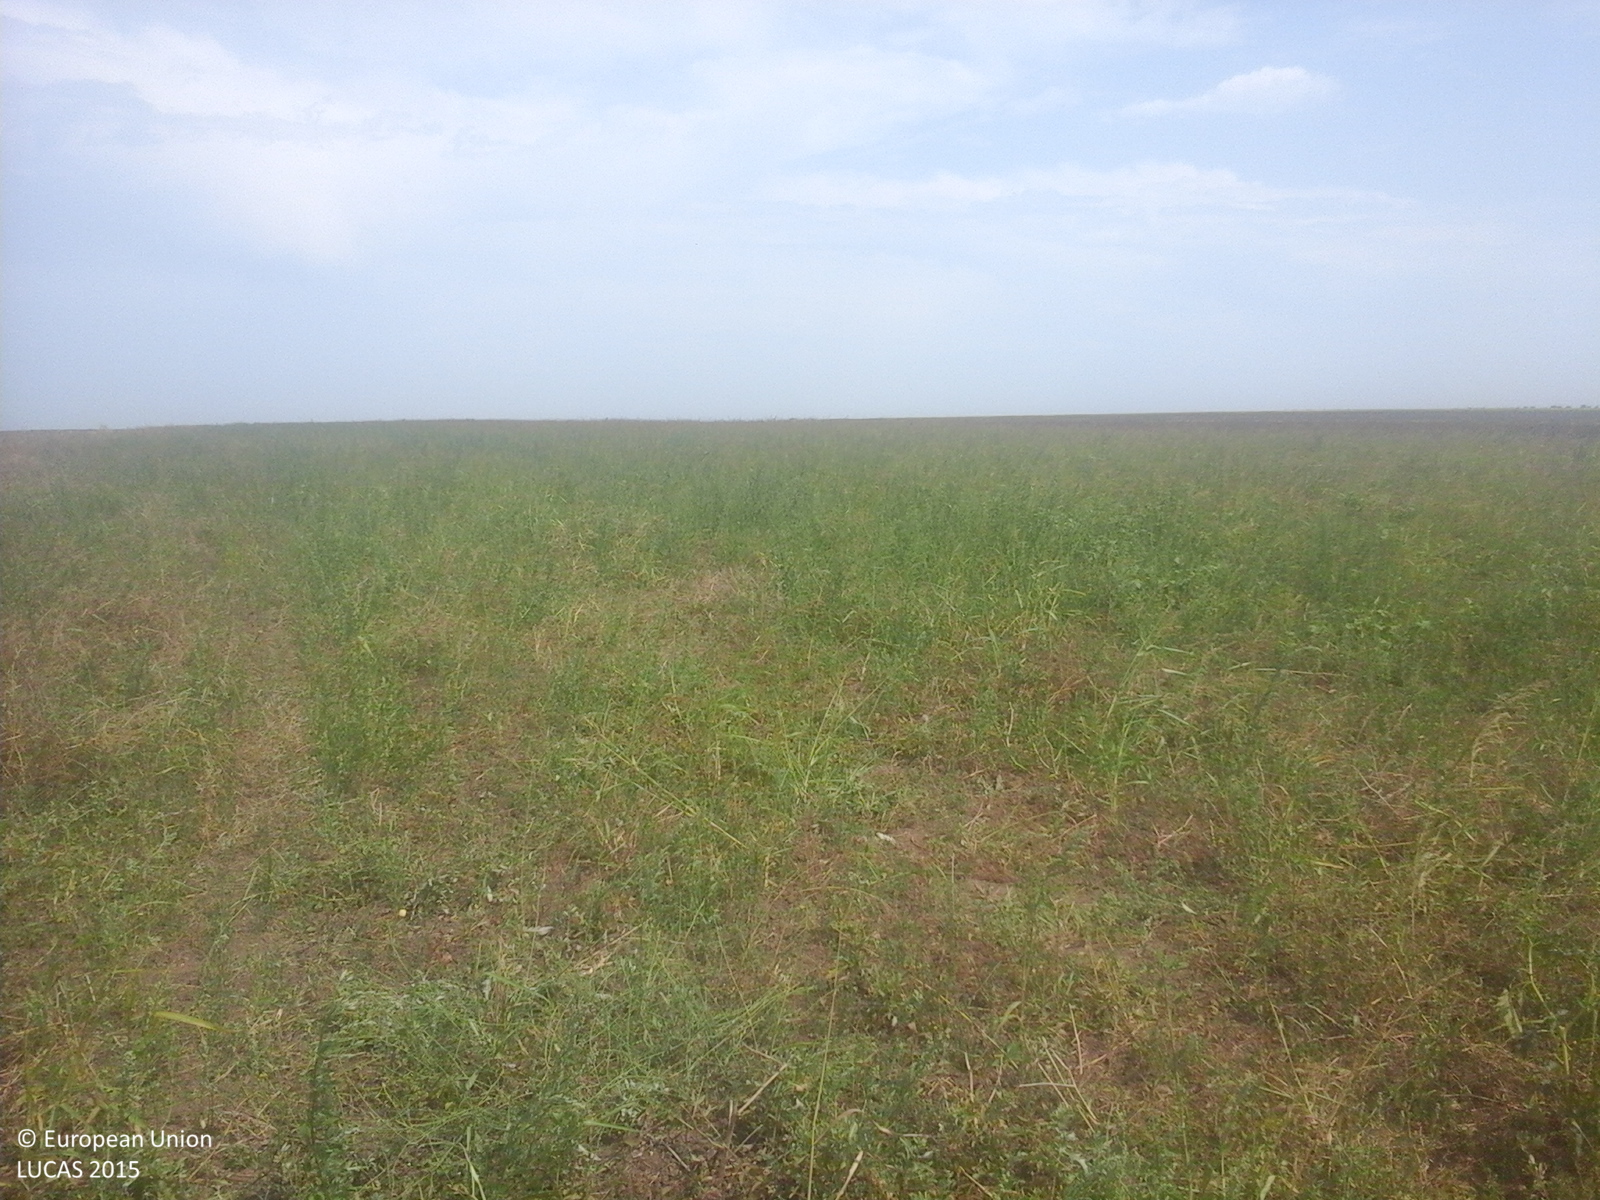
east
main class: Grassland
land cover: Spontaneously vegetated surfaces
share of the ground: < 10 %
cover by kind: herbaceous plants 100 %
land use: Fallow land
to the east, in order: Spontaneously vegetated surfaces
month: August
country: RO
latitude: 43.9404
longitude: 28.3127
